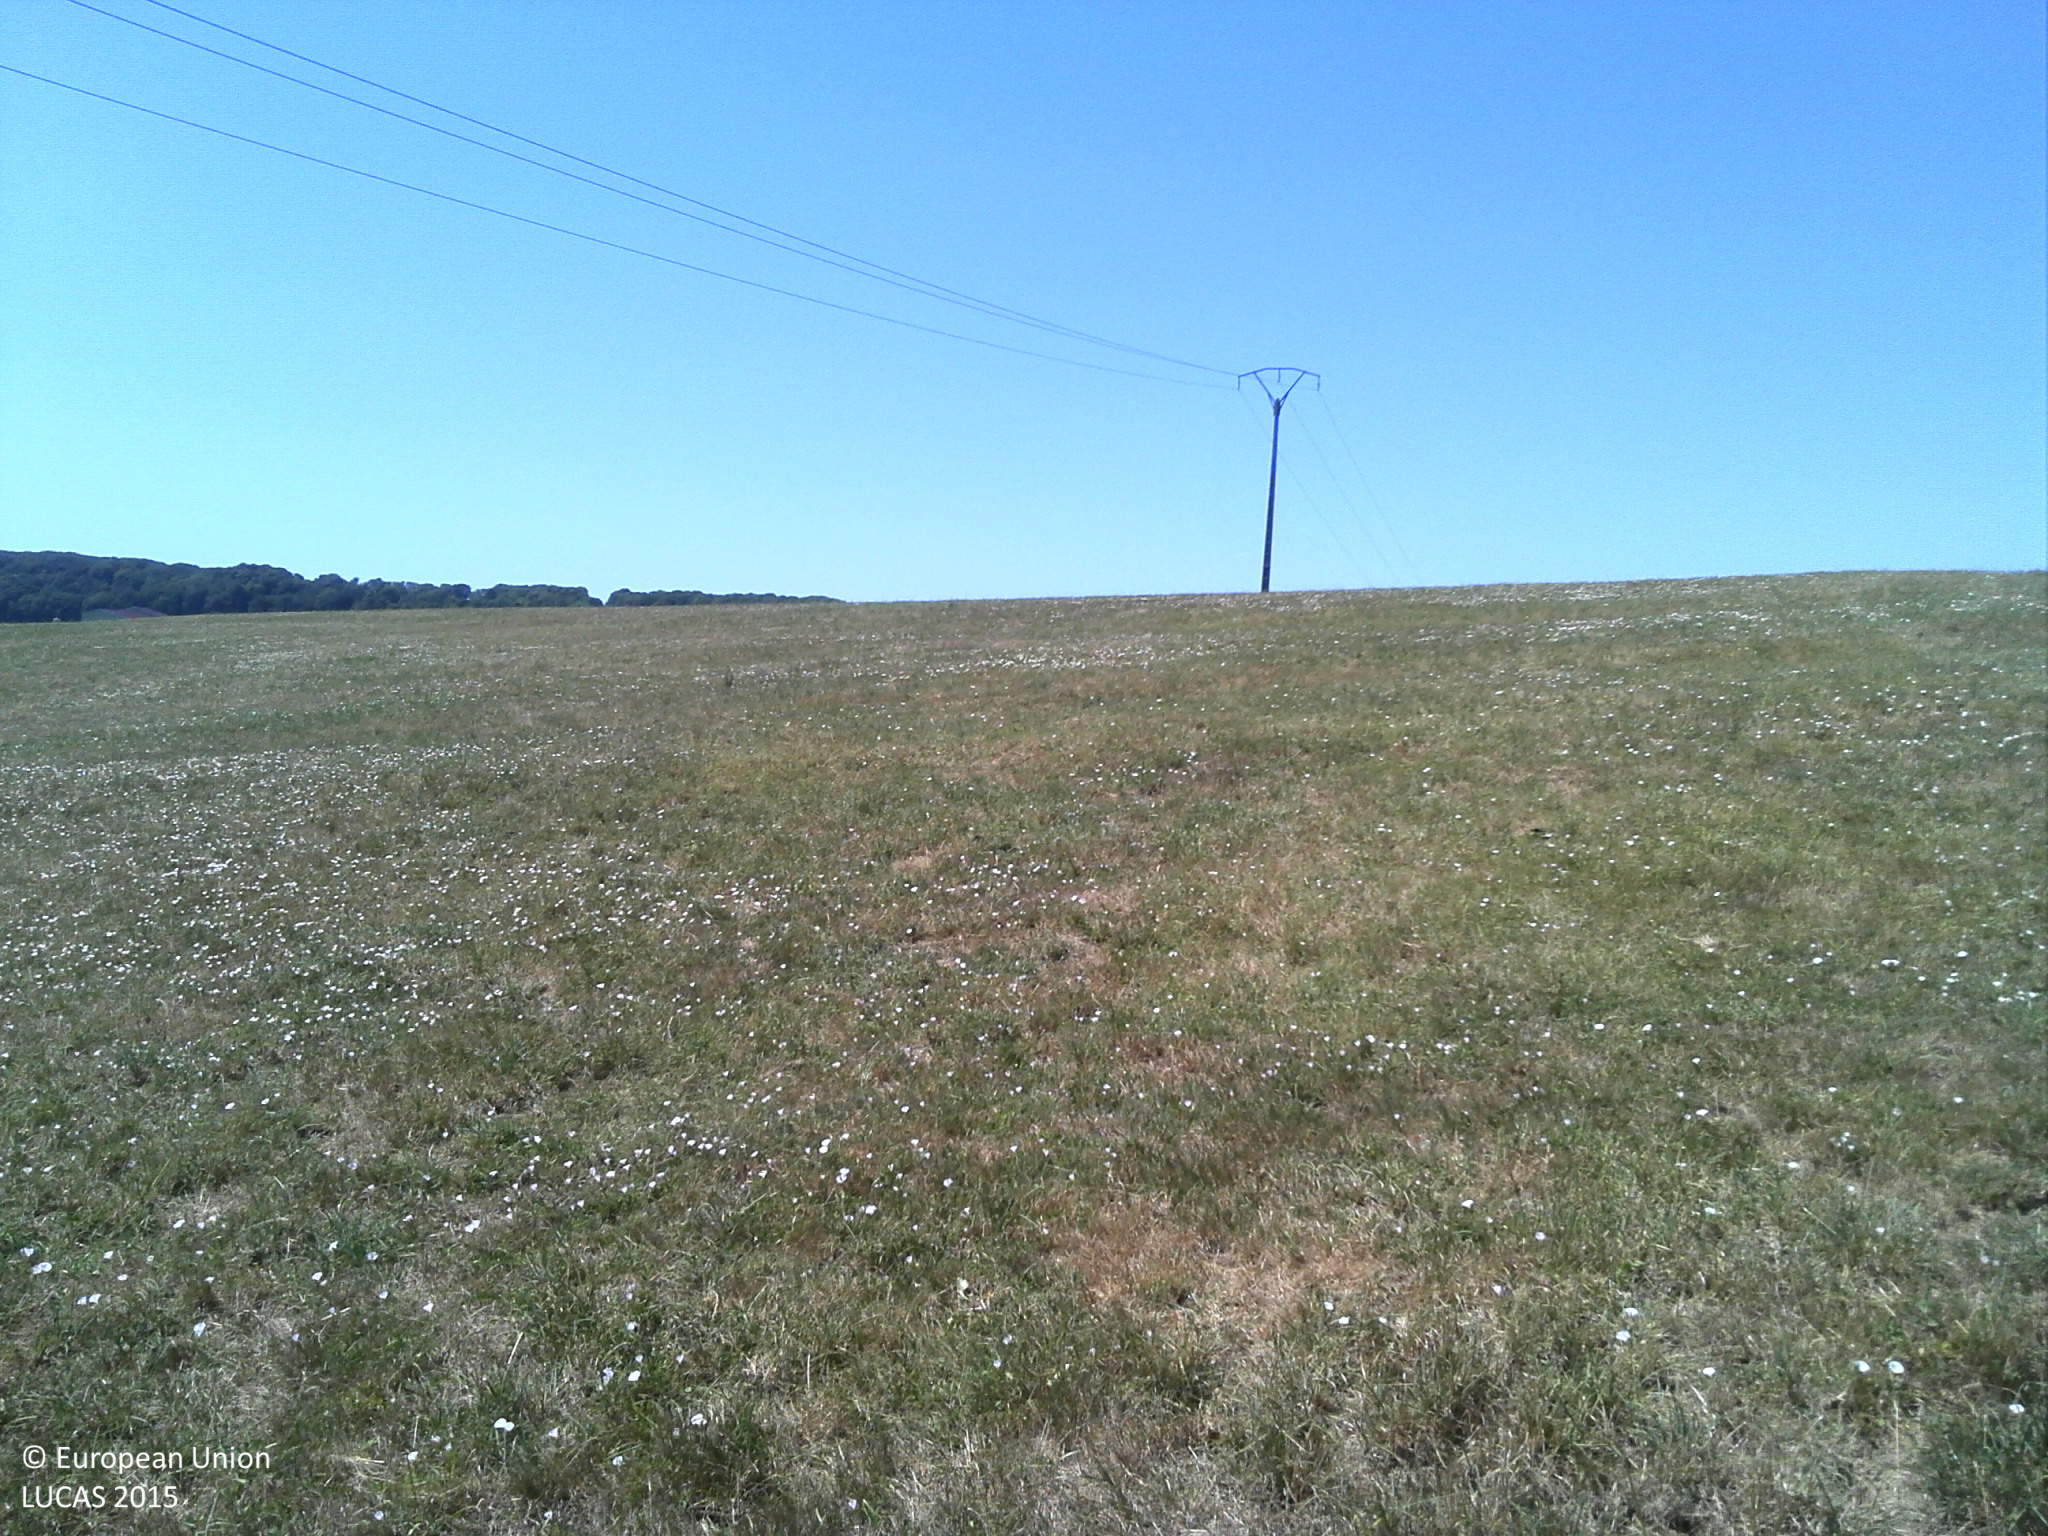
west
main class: Grassland
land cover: Grassland without tree/shrub cover
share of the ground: > 75 %
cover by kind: herbaceous plants 100 %
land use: Agriculture (excluding fallow land and kitchen gardens)
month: July
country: FR
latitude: 49.4559
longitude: 6.2334
